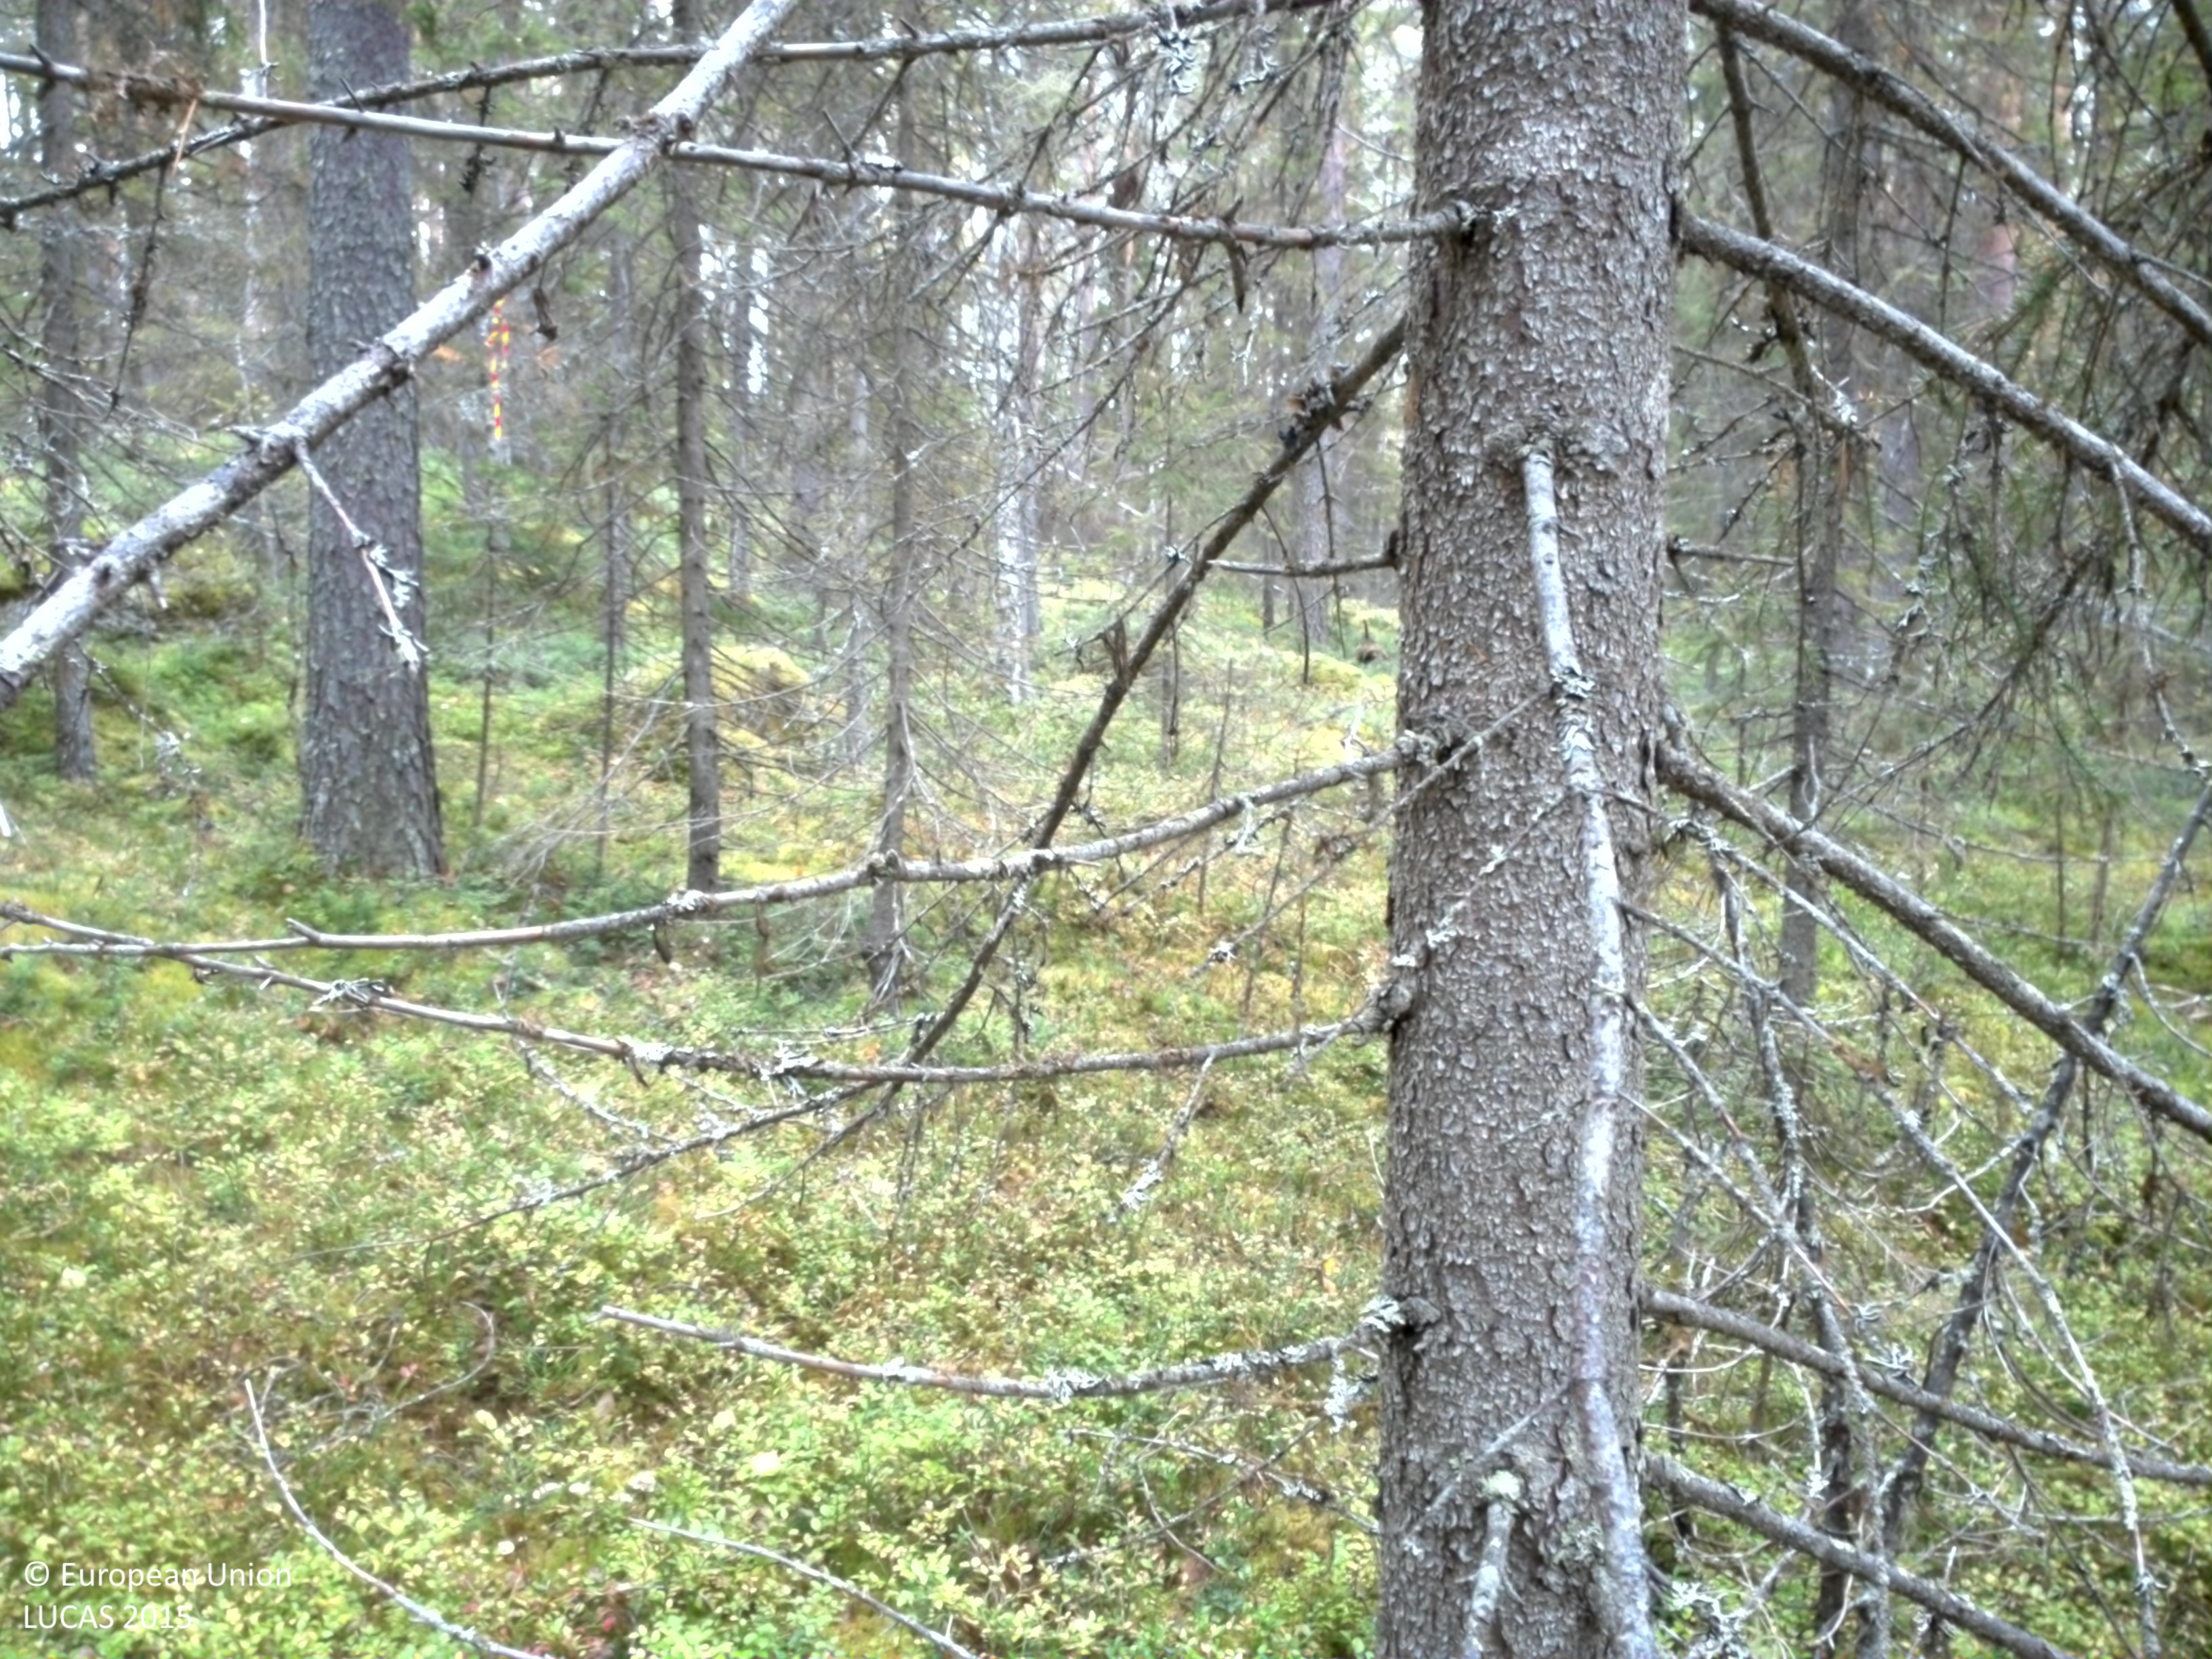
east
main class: Woodland
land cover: Pine dominated coniferous woodland
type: boreal forest
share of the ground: 25 - 50 %
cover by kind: shrubs 65 %, coniferous forest trees 35 %
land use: Forestry
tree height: > 5 m
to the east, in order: Pine dominated coniferous woodland; Other coniferous woodland; Broadleaved woodland; Rivers and streams; Pine dominated coniferous woodland
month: September
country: SE
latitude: 65.8594
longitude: 21.8279
